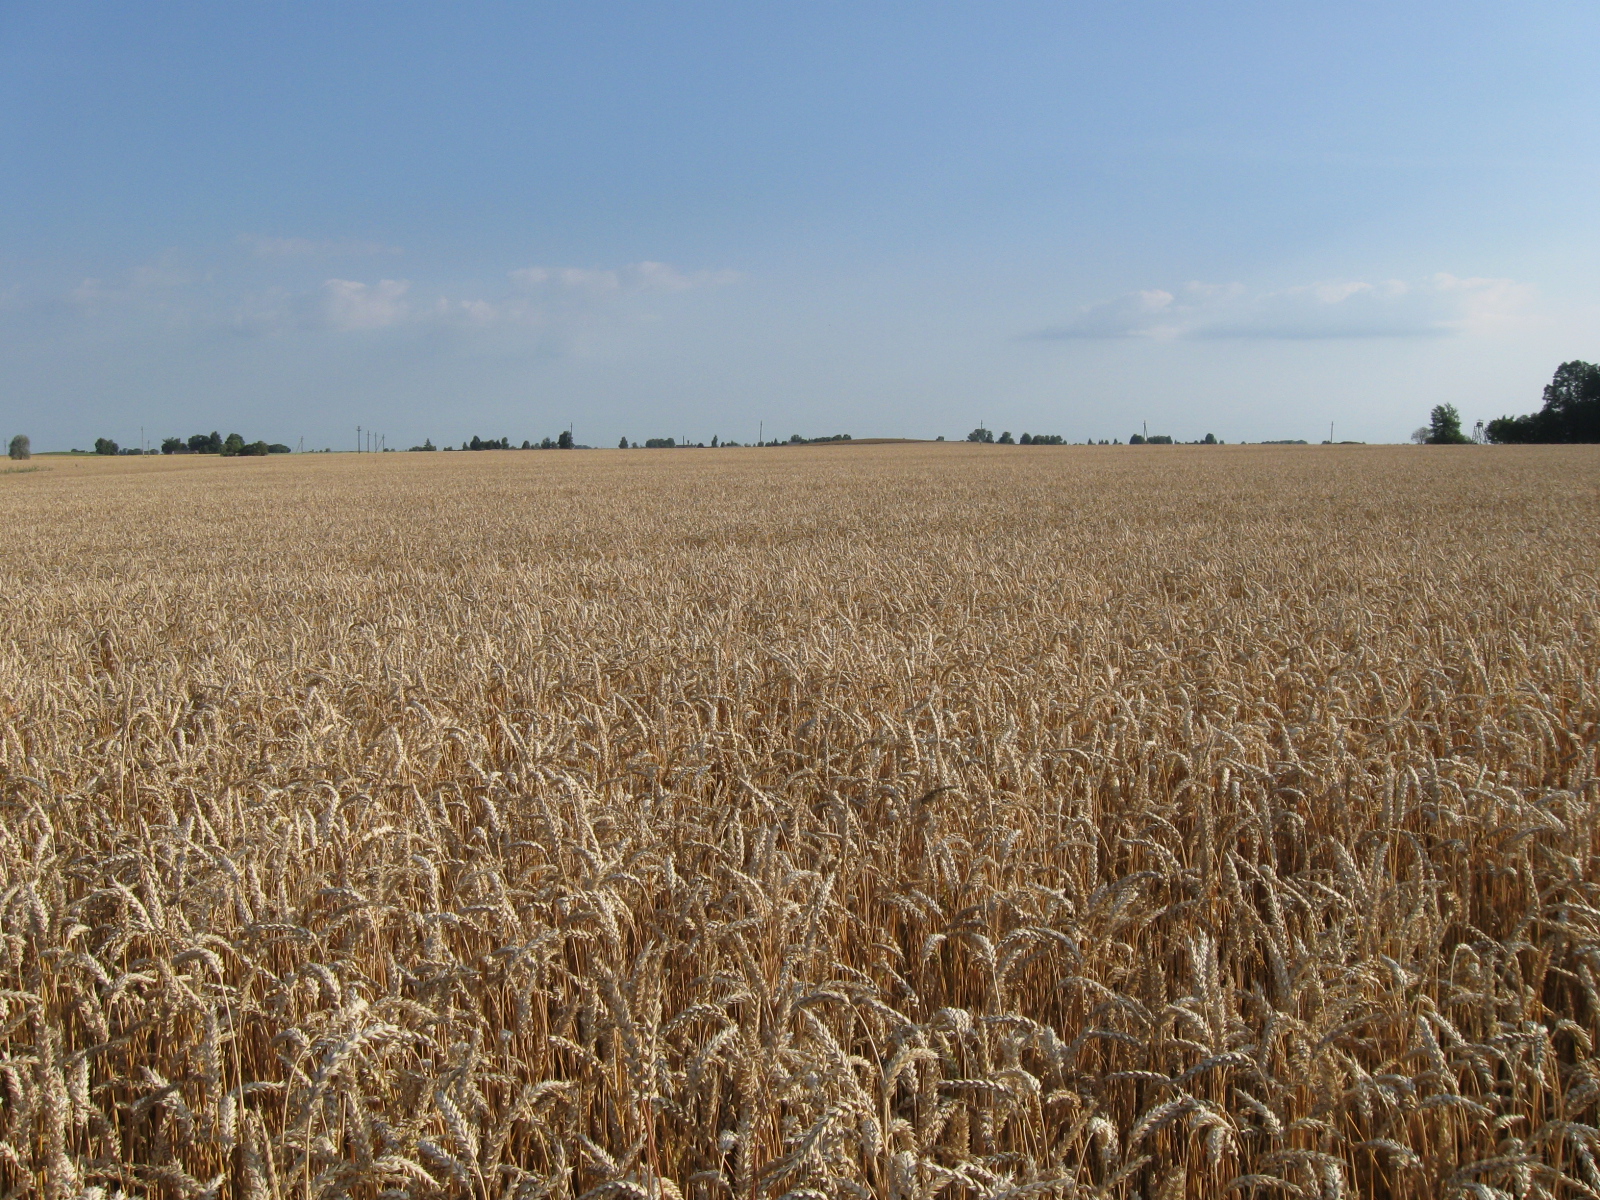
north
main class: Cropland
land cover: Common wheat
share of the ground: > 75 %
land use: Agriculture (excluding fallow land and kitchen gardens)
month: July
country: LT
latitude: 54.4561
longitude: 23.4230
